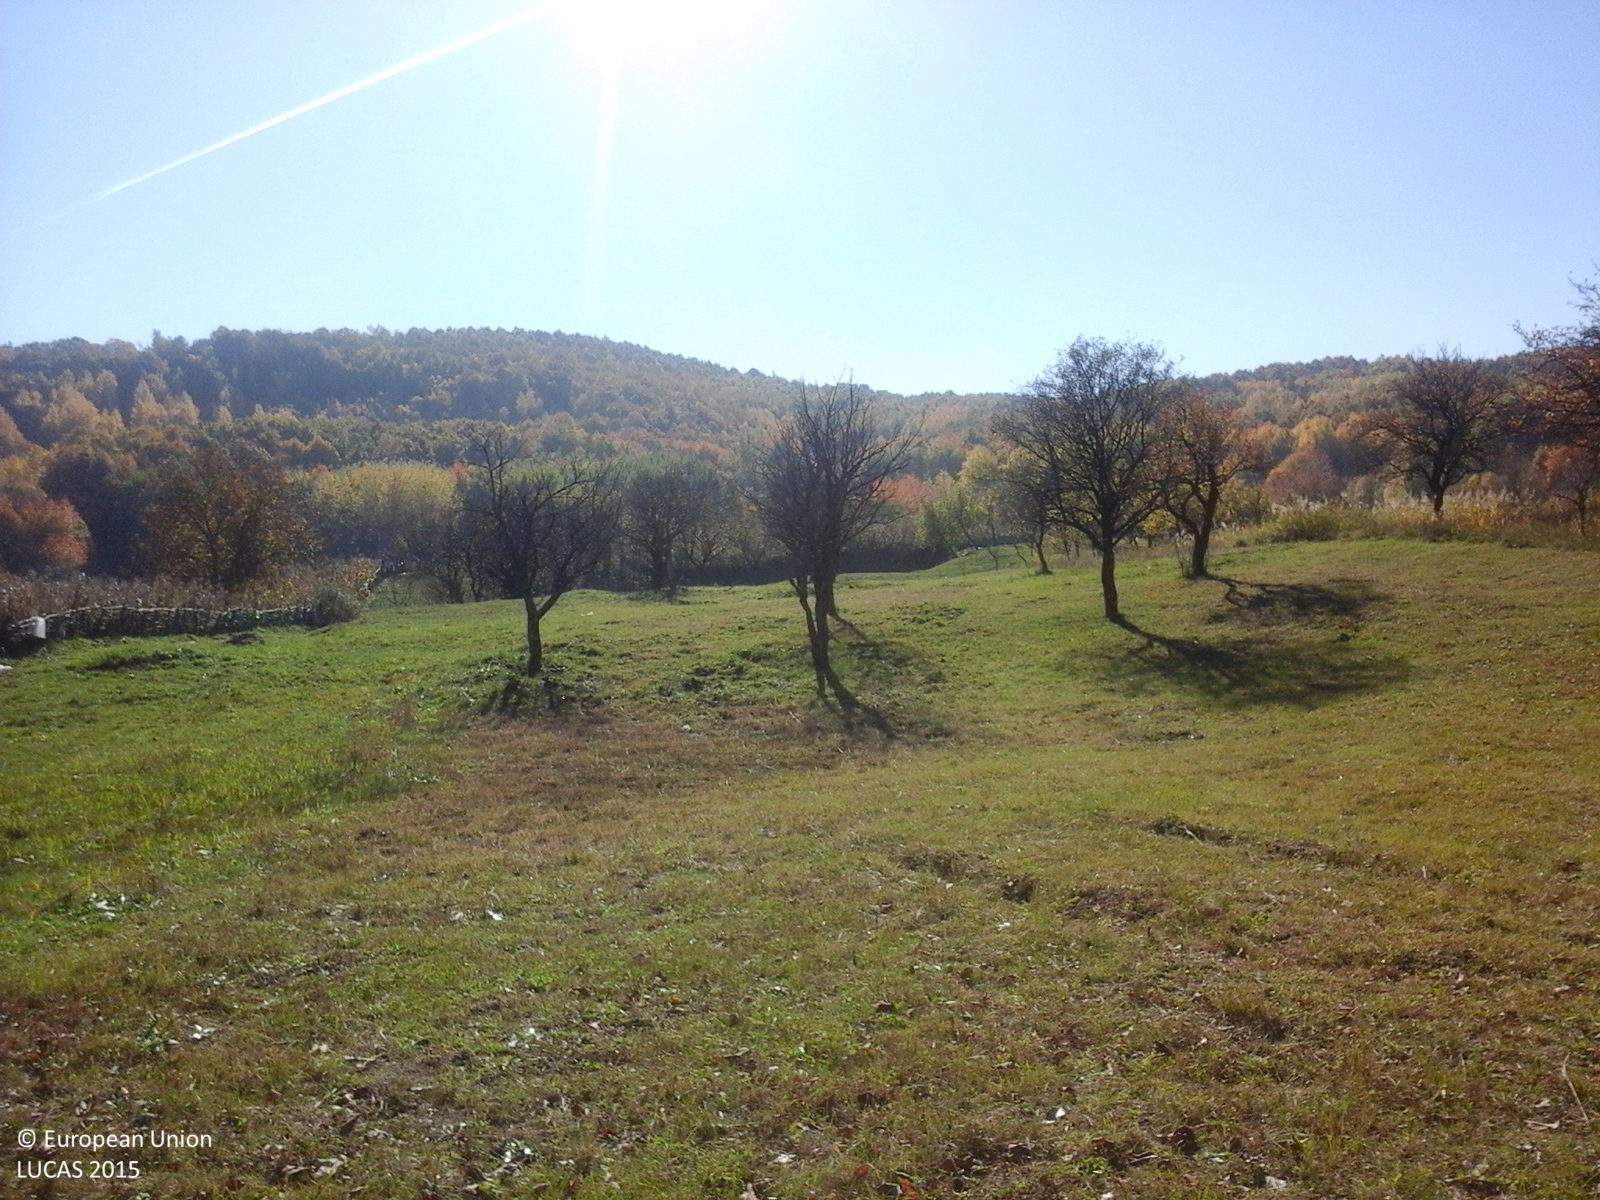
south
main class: Cropland
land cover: Other fruit trees and berries
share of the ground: 25 - 50 %
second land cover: Grassland without tree/shrub cover
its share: > 75 %
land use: Agriculture (excluding fallow land and kitchen gardens)
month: October
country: RO
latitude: 45.4833
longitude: 26.8302
